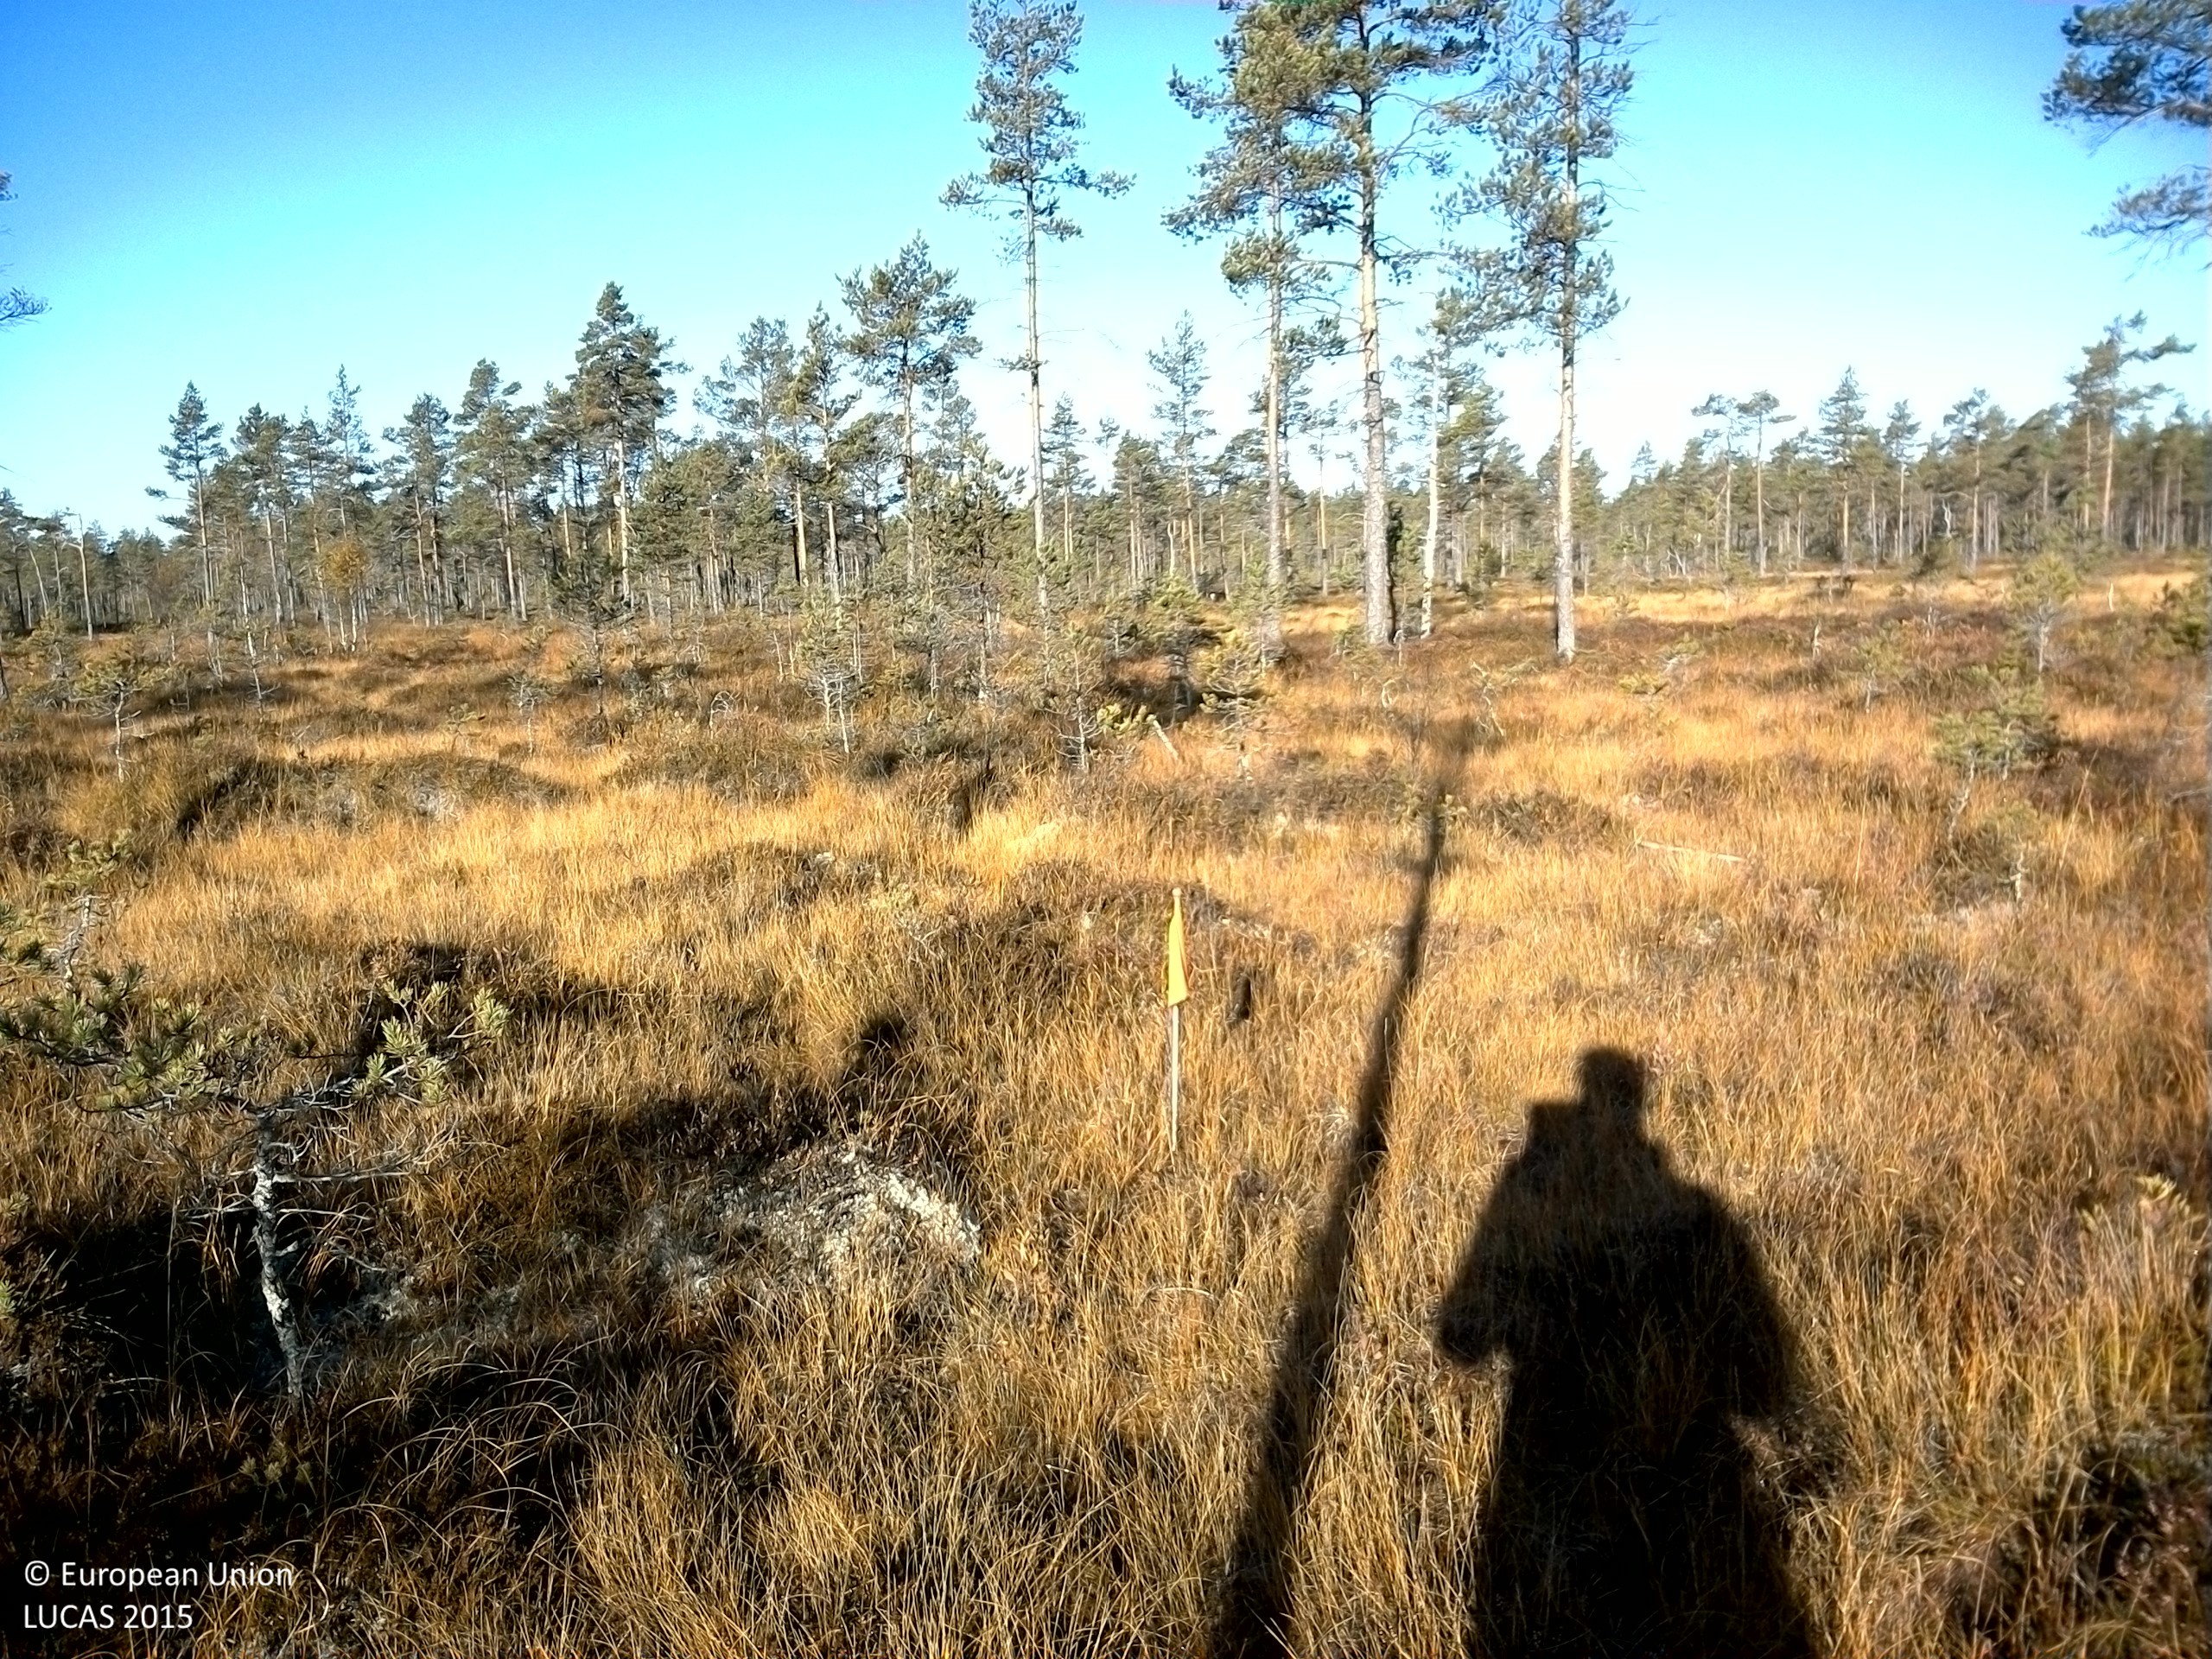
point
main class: Woodland
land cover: Pine dominated coniferous woodland
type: boreal forest
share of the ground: 10 - 25 %
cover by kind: shrubs 40 %, coniferous forest trees 20 %, herbaceous plants 20 %, lichens and mosses 20 %
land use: Forestry
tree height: < 5 m
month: October
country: SE
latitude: 61.1994
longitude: 15.3256
